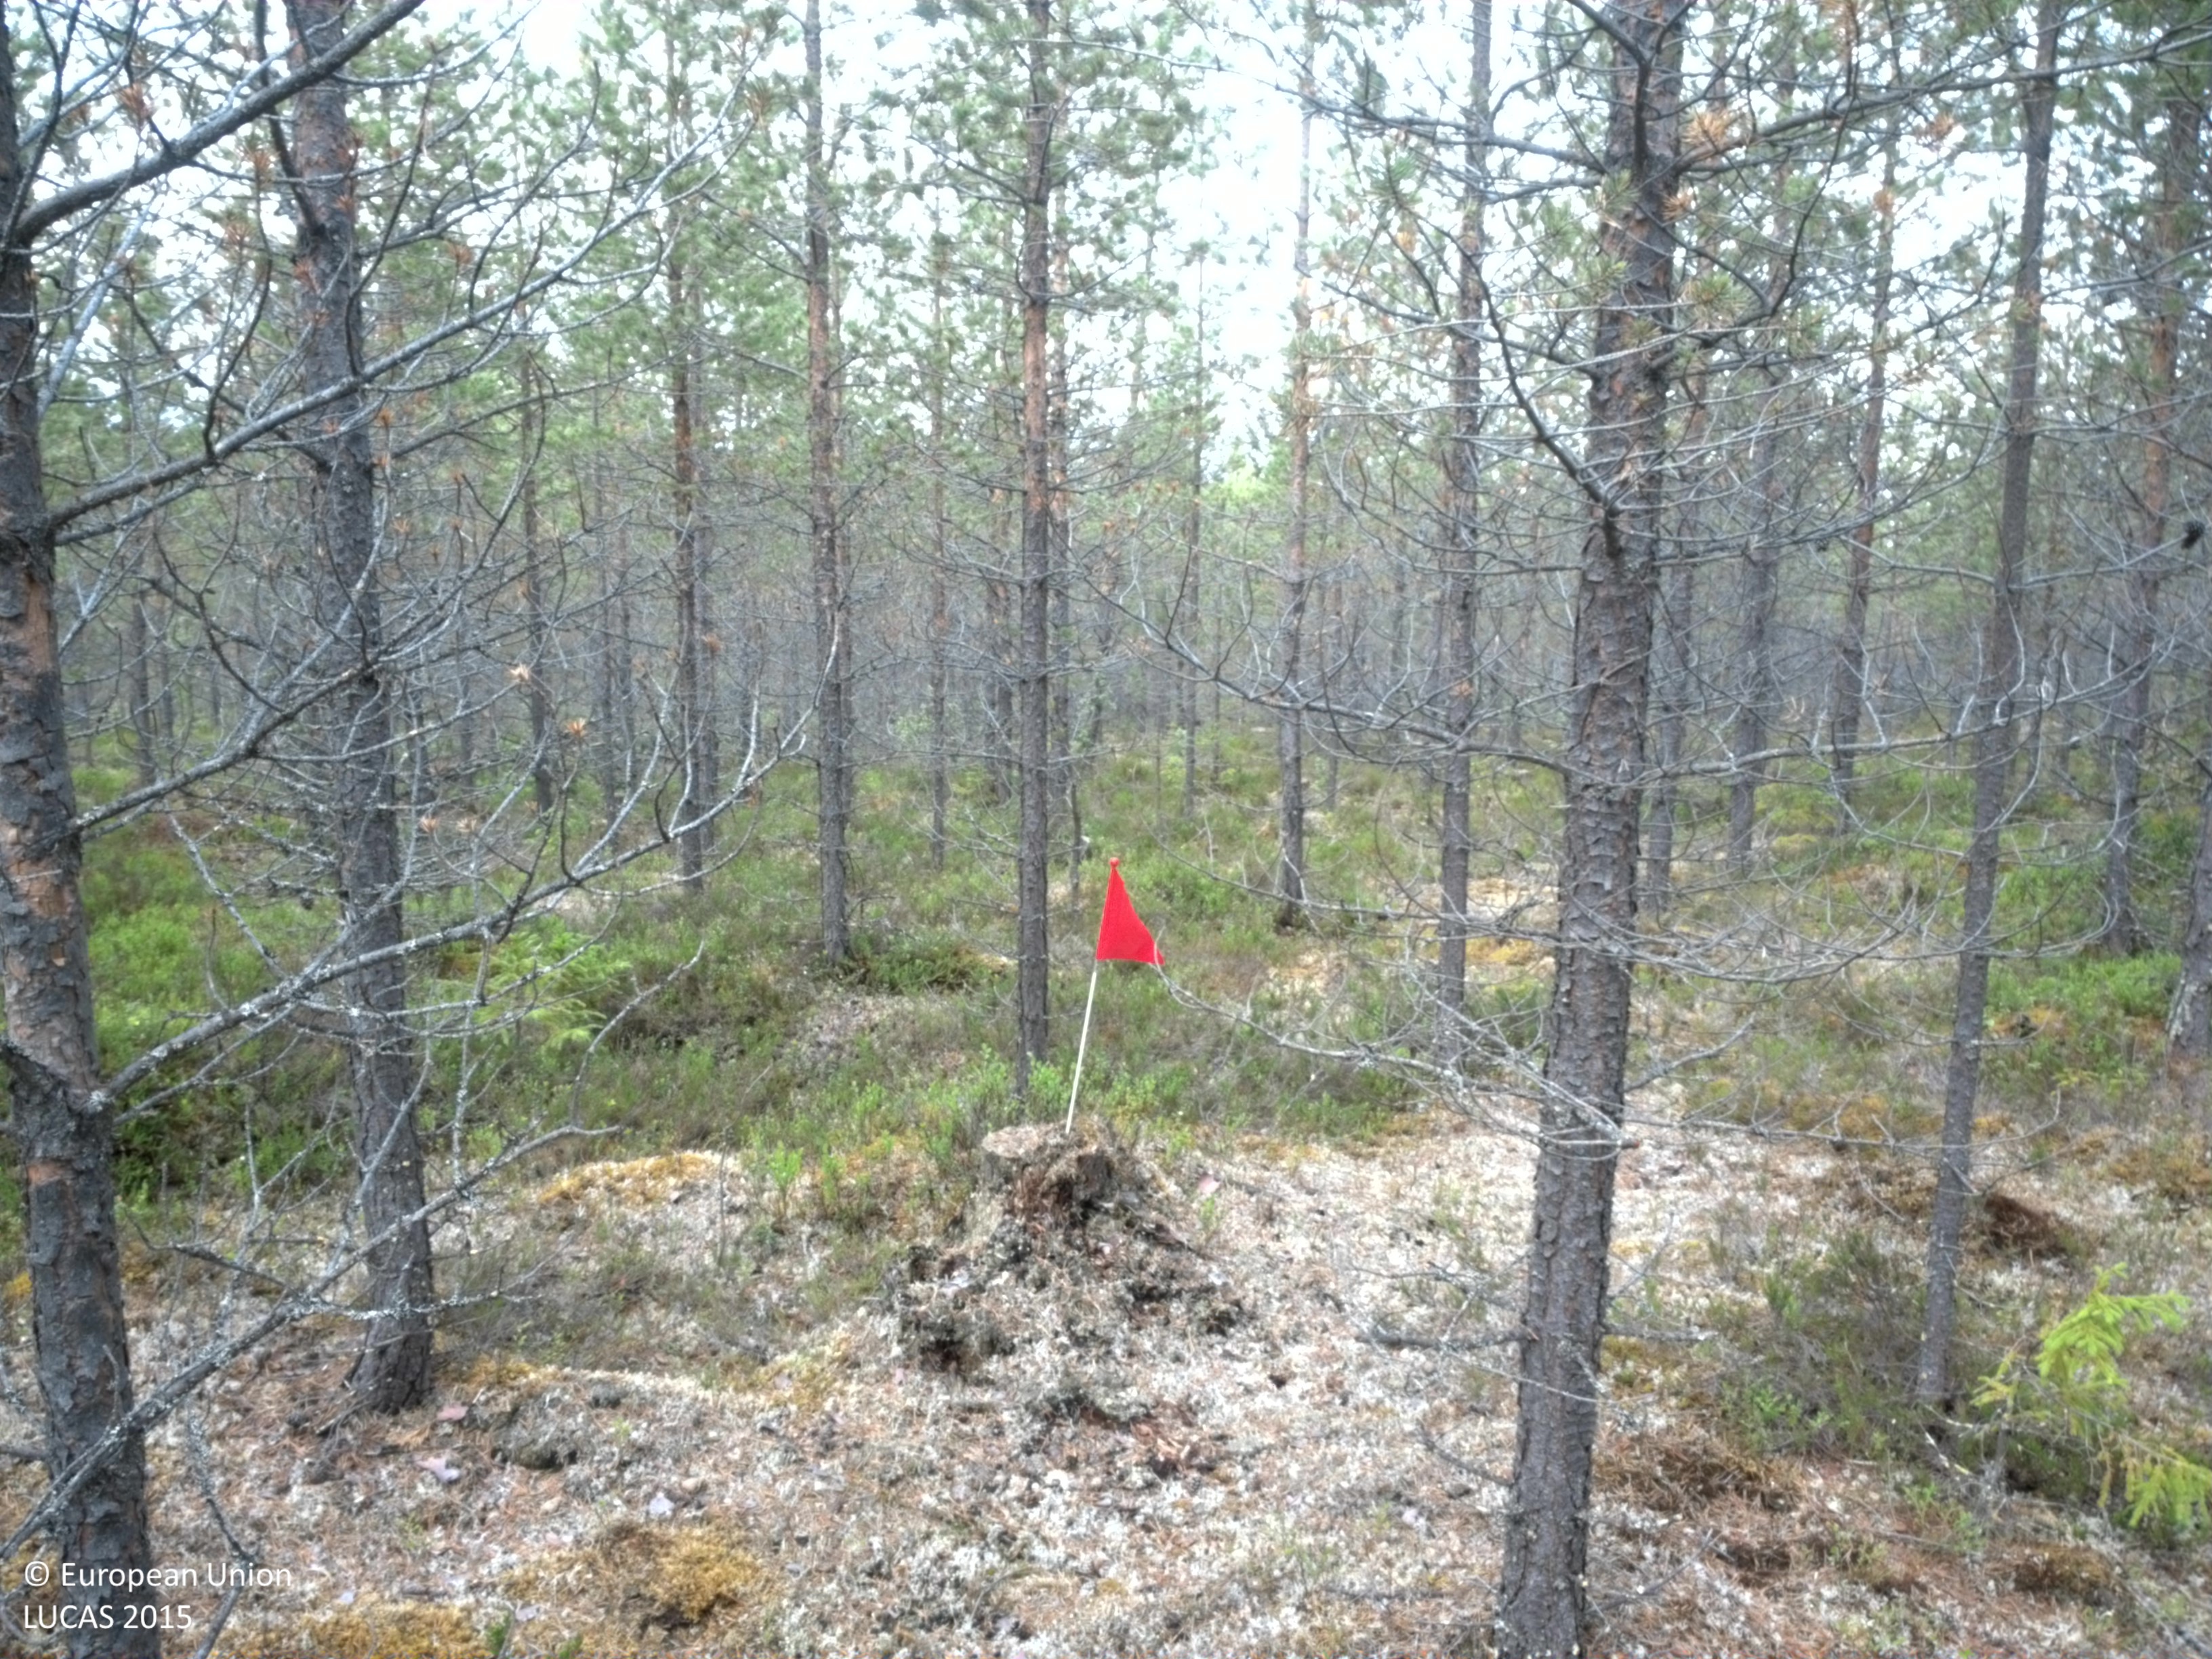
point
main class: Woodland
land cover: Pine dominated coniferous woodland
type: boreal forest
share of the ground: 50 - 75 %
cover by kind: coniferous forest trees 75 %, shrubs 15 %, lichens and mosses 10 %
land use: Forestry
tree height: > 5 m
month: July
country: SE
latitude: 64.7239
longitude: 18.3414
